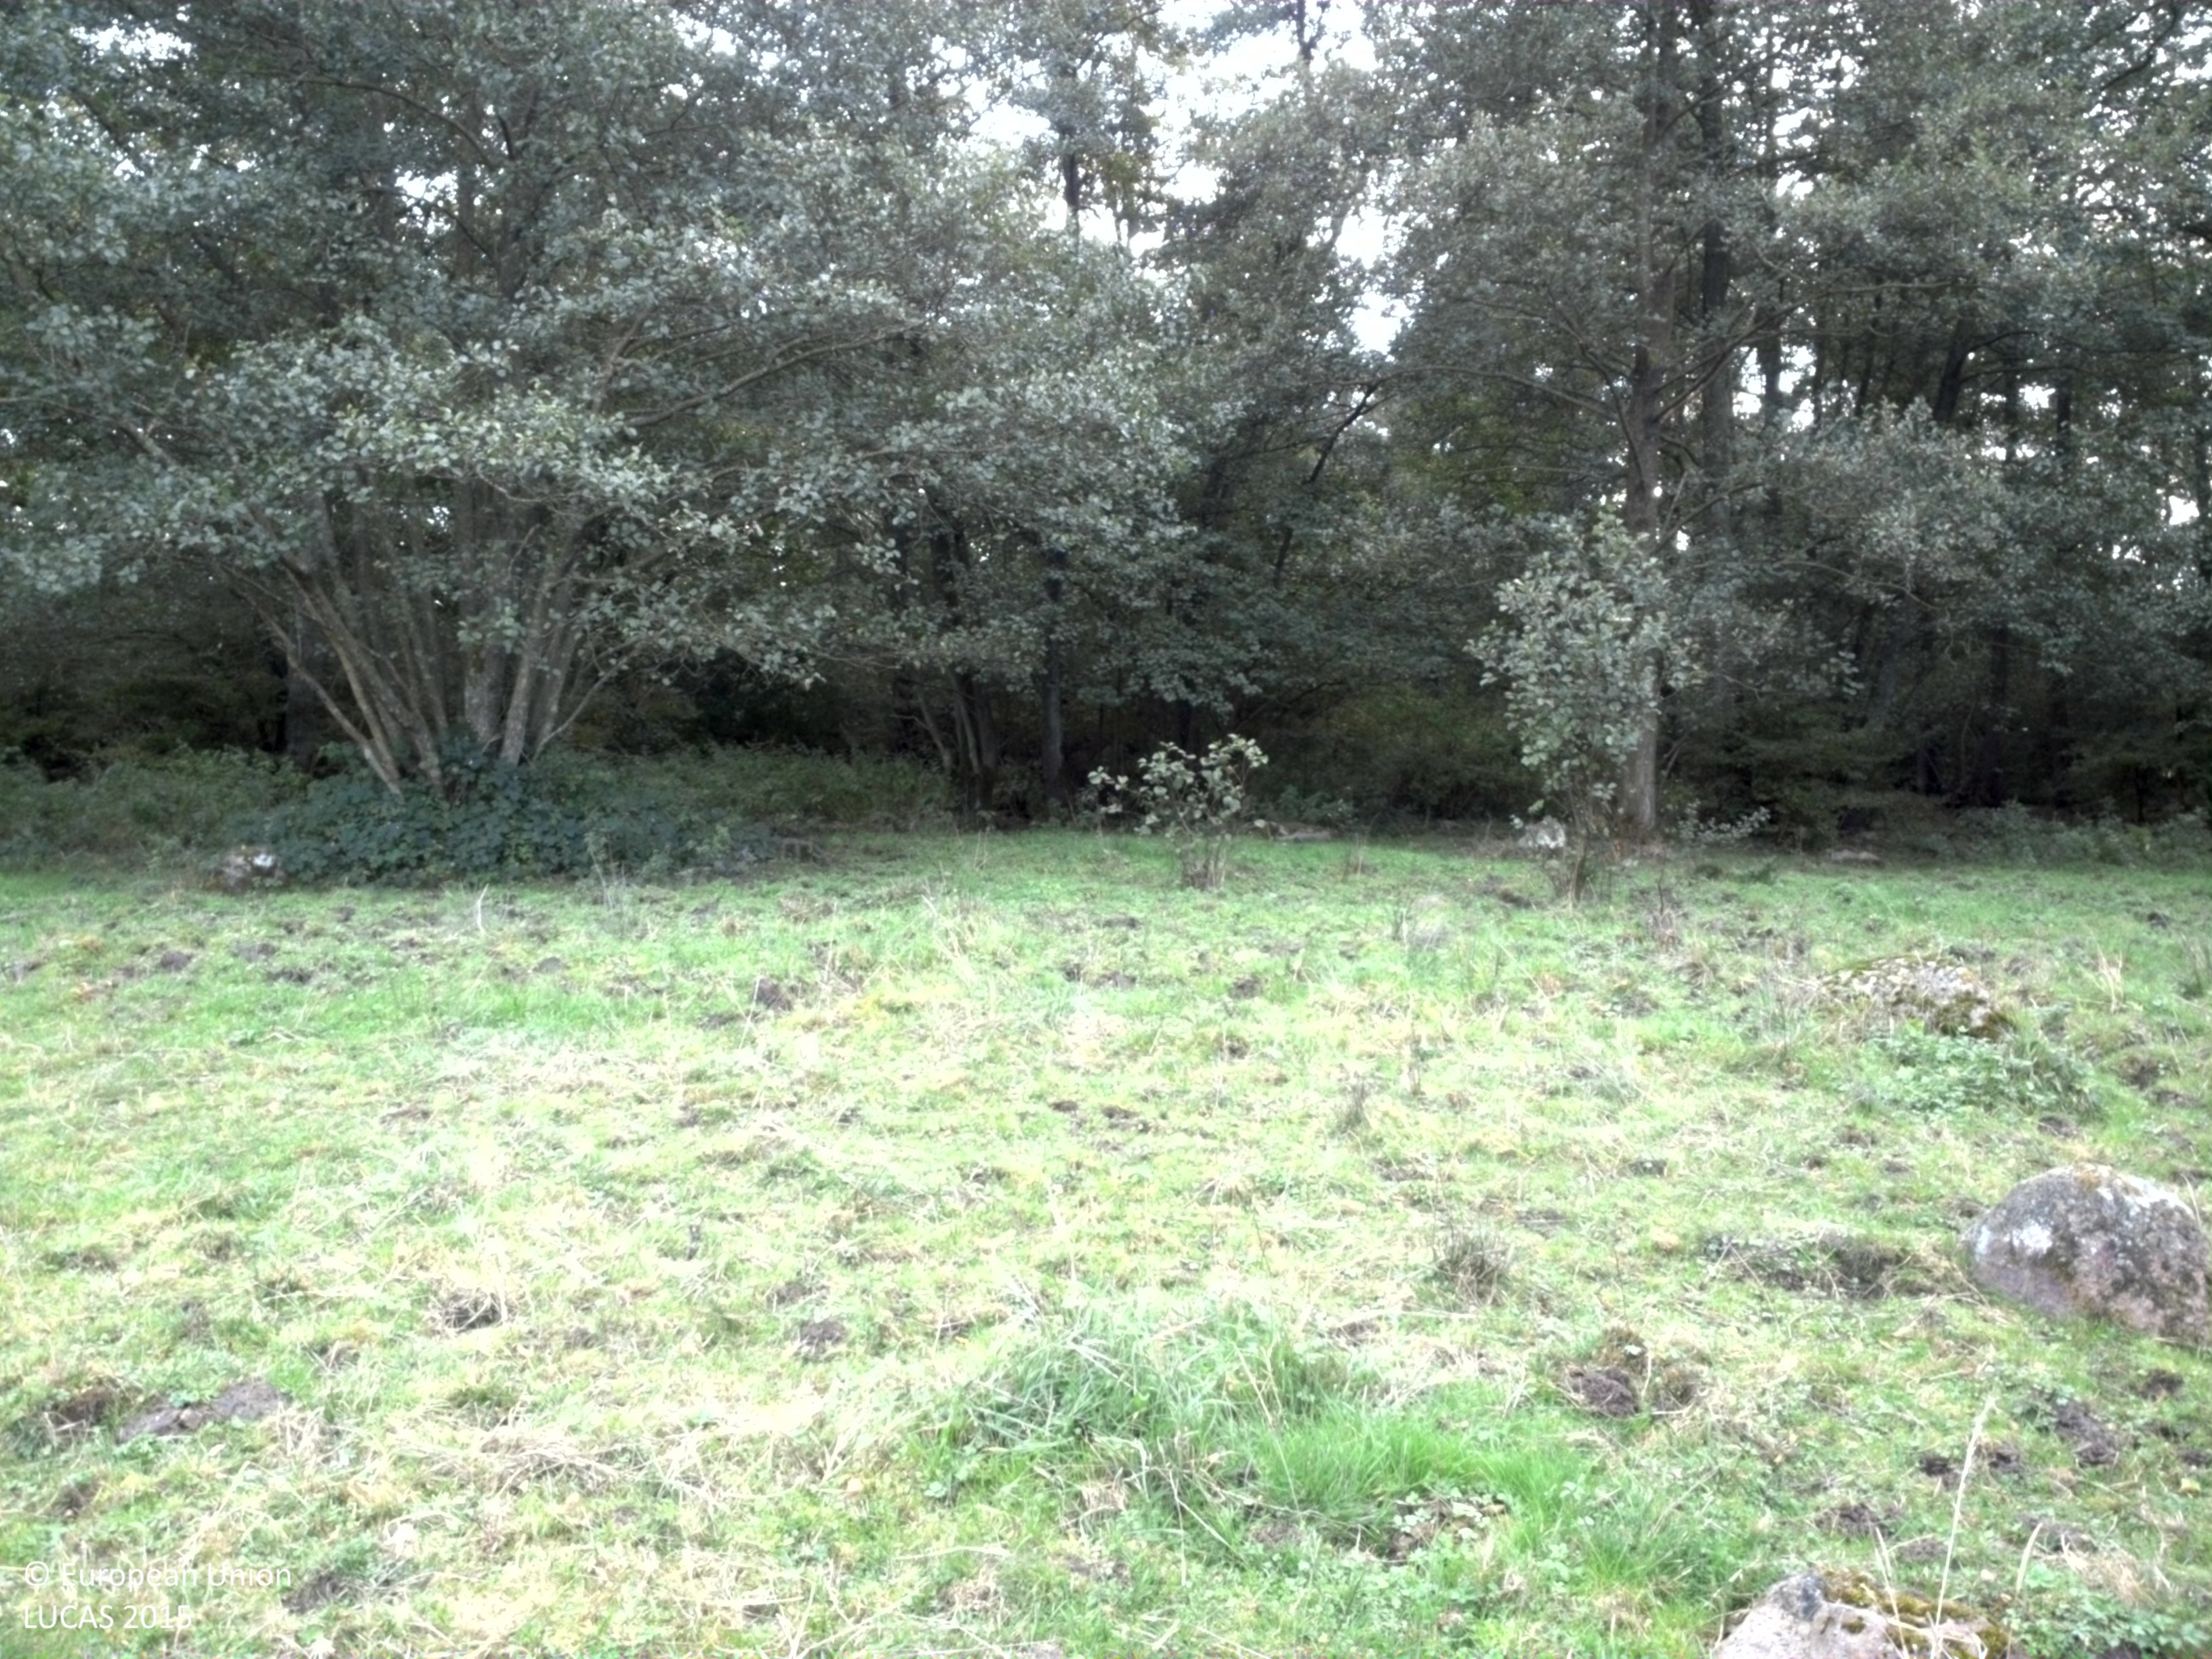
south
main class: Grassland
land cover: Grassland with sparse tree/shrub cover
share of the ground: > 75 %
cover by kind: herbaceous plants 90 %, broadleaved forest trees 5 %, consolidated bare surface 5 %
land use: Agriculture (excluding fallow land and kitchen gardens)
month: October
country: SE
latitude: 55.6507
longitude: 14.2098
